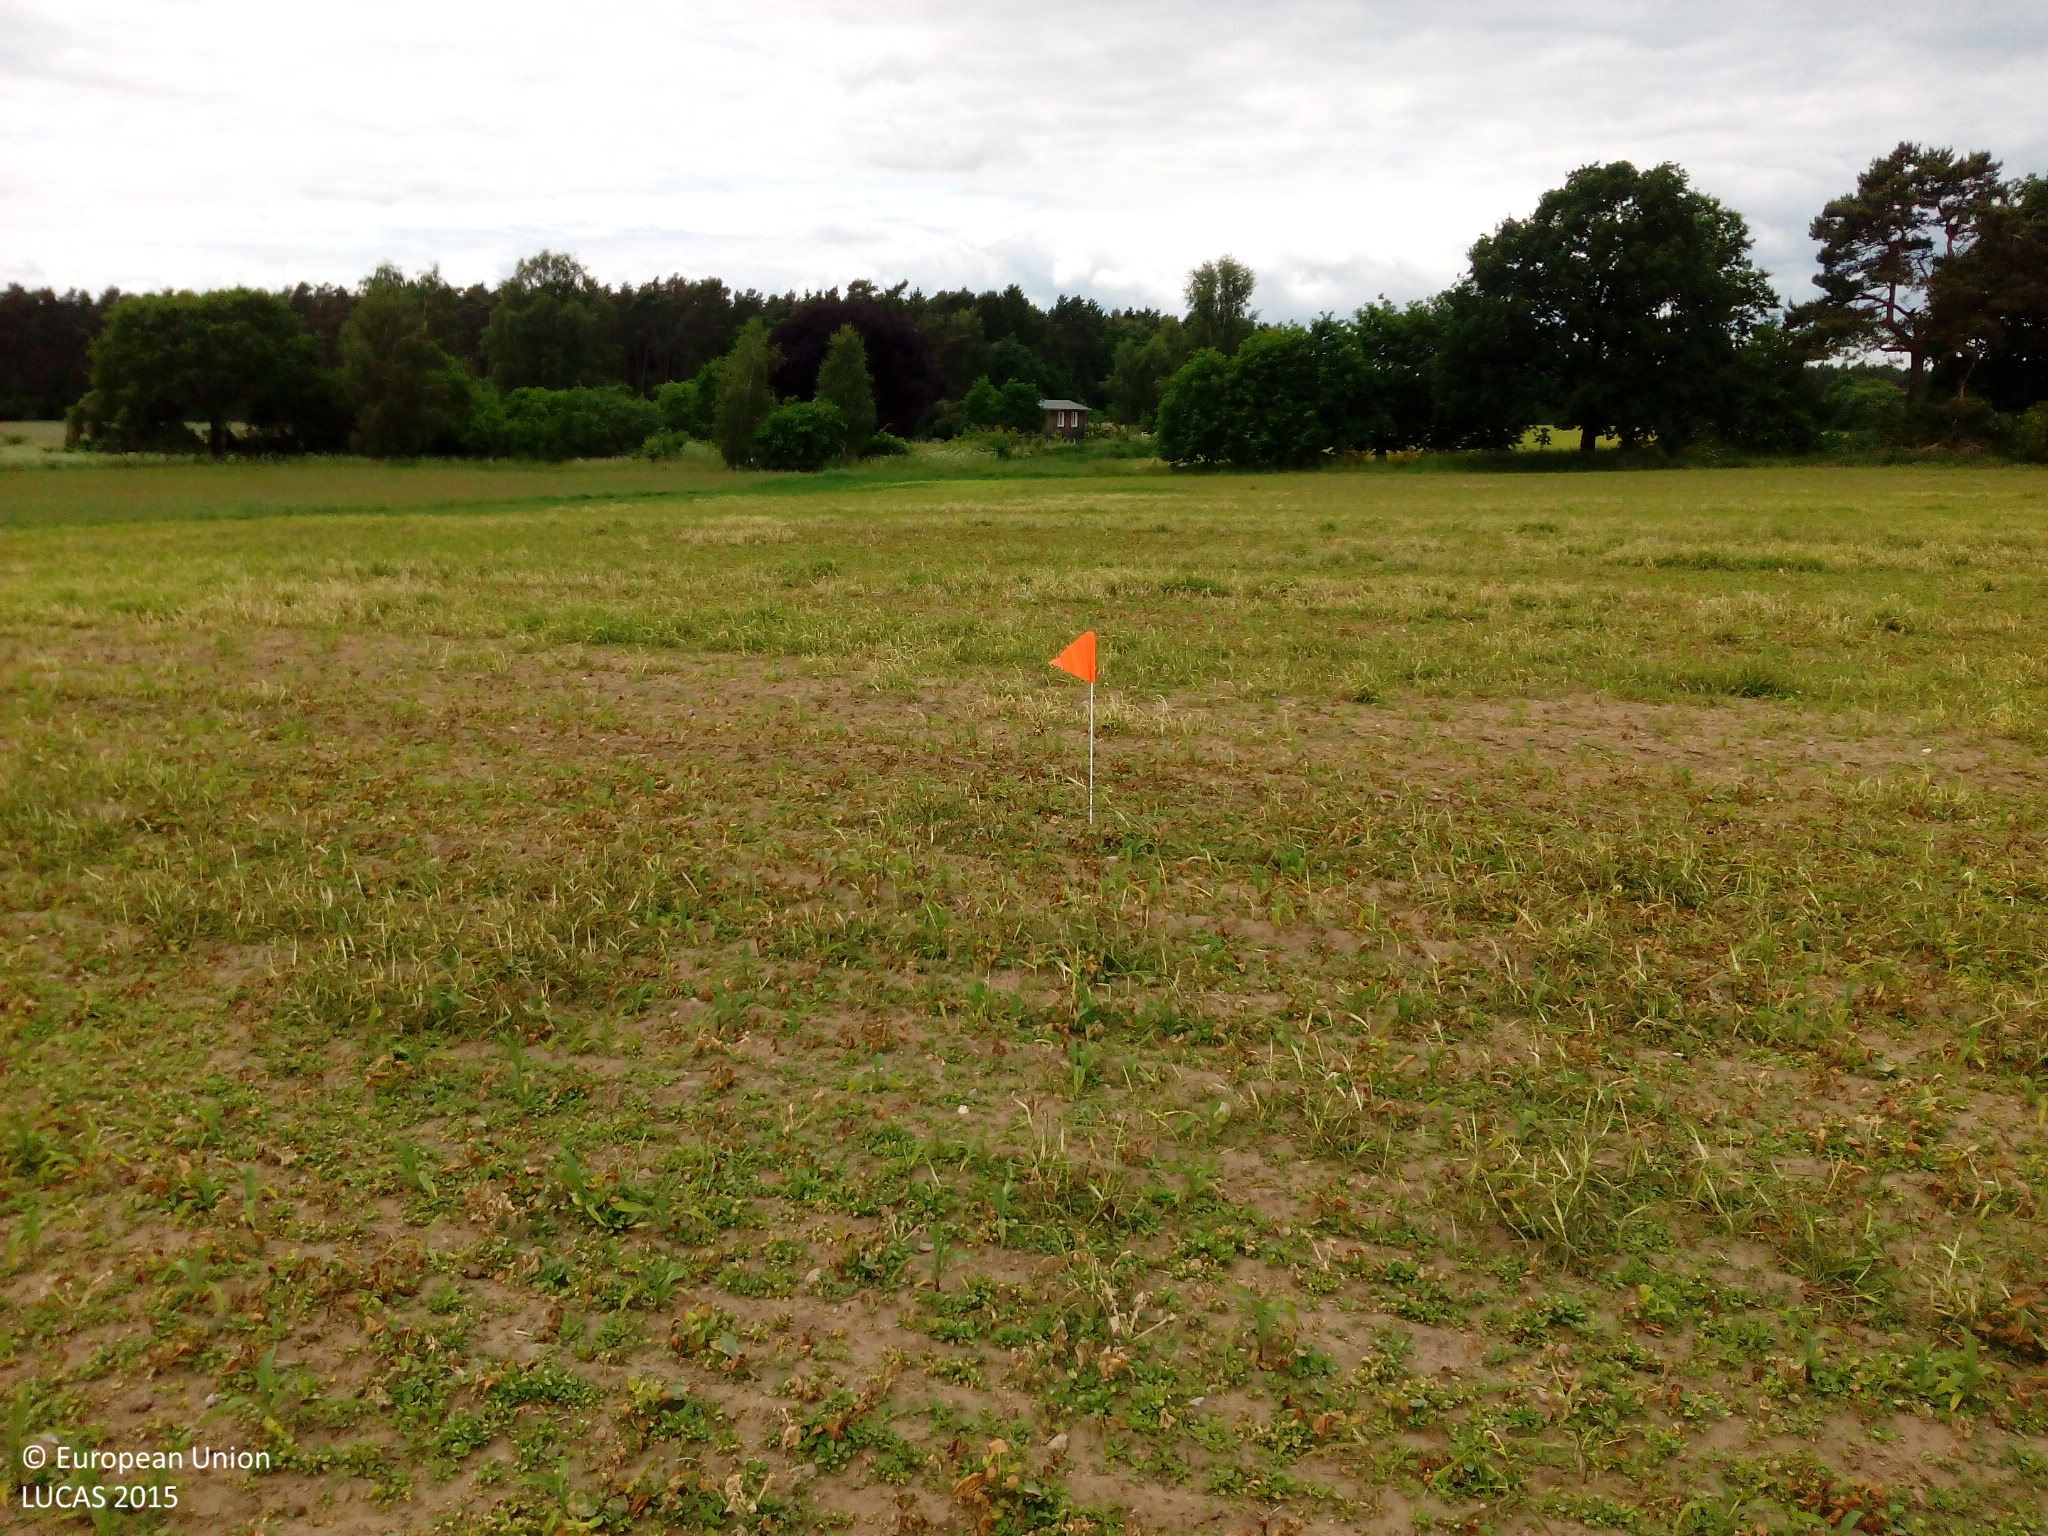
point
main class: Cropland
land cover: Maize
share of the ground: < 10 %
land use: Agriculture (excluding fallow land and kitchen gardens)
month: June
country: DE
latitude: 53.3969
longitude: 12.3604
